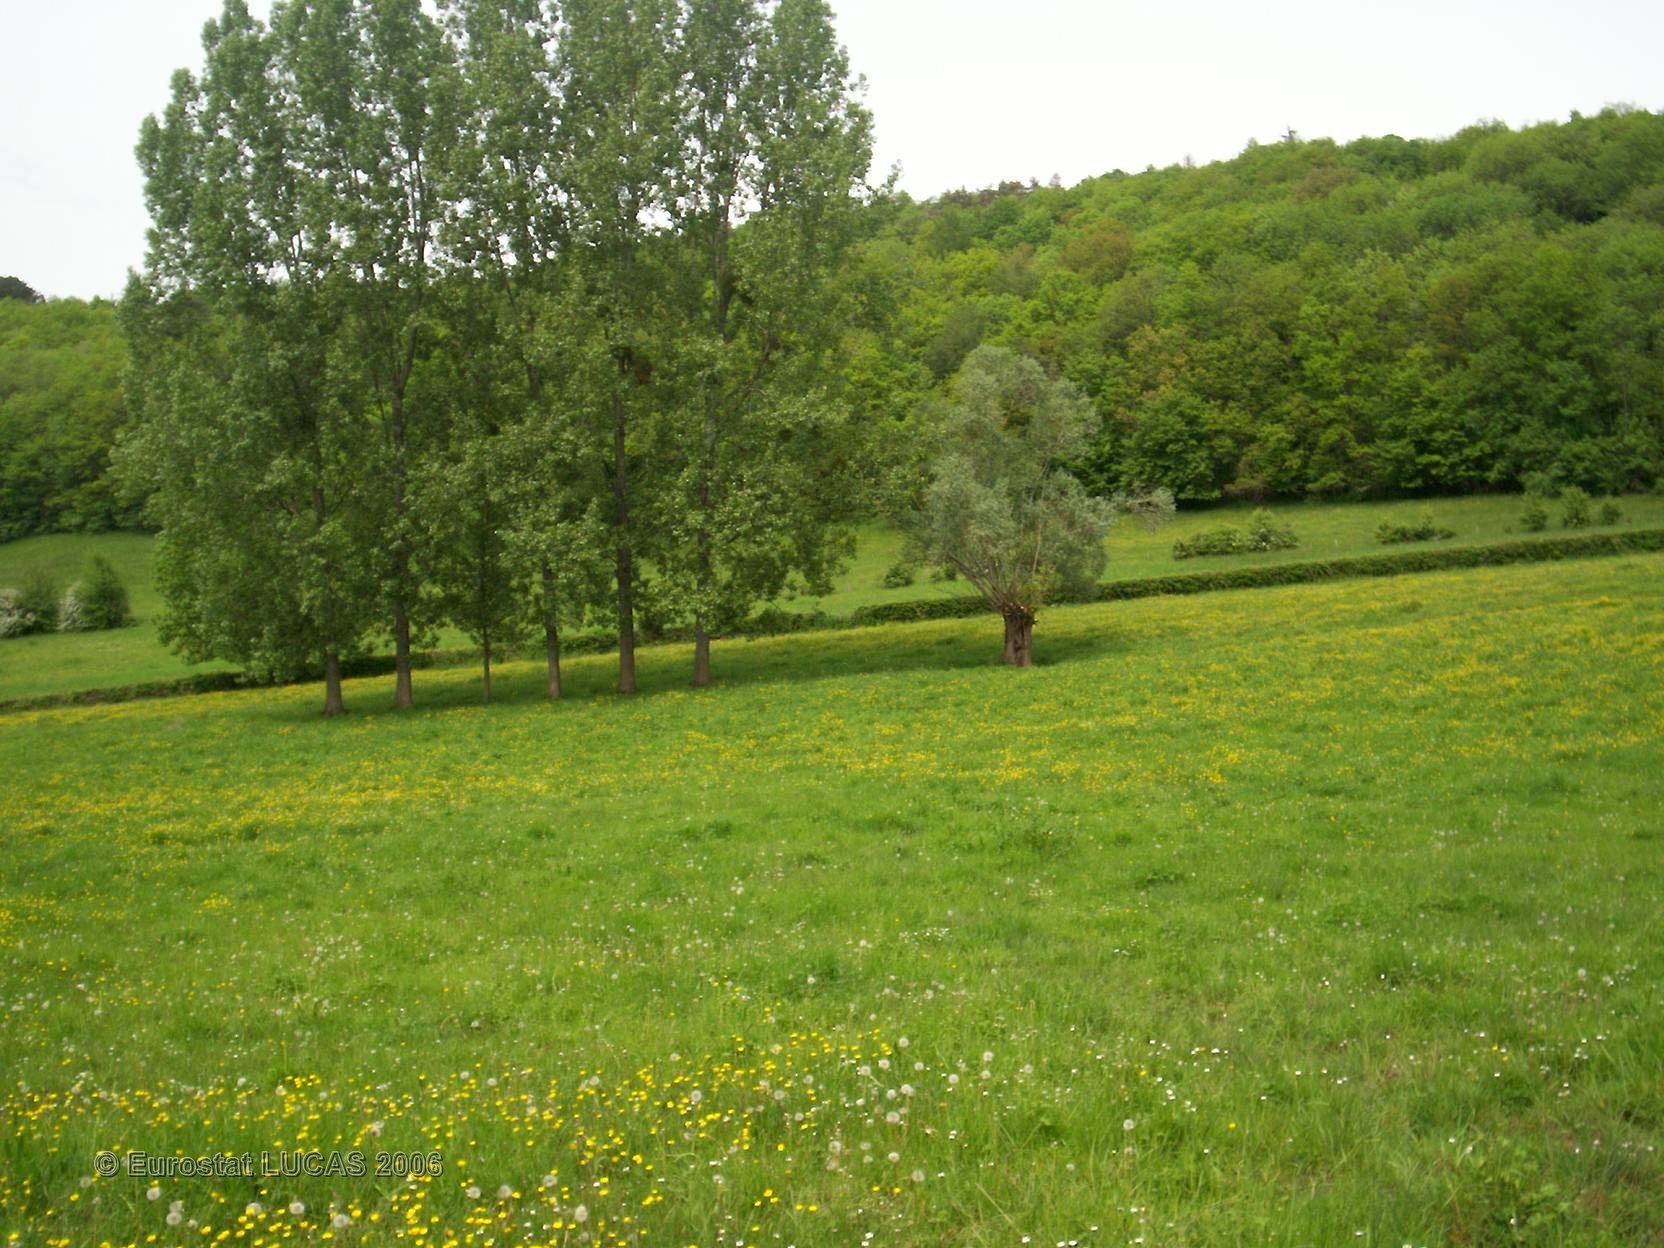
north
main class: Grassland
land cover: Grassland without tree/shrub cover
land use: Agriculture (excluding fallow land and kitchen gardens)
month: May
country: FR
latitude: 47.3164
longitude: 4.6154
